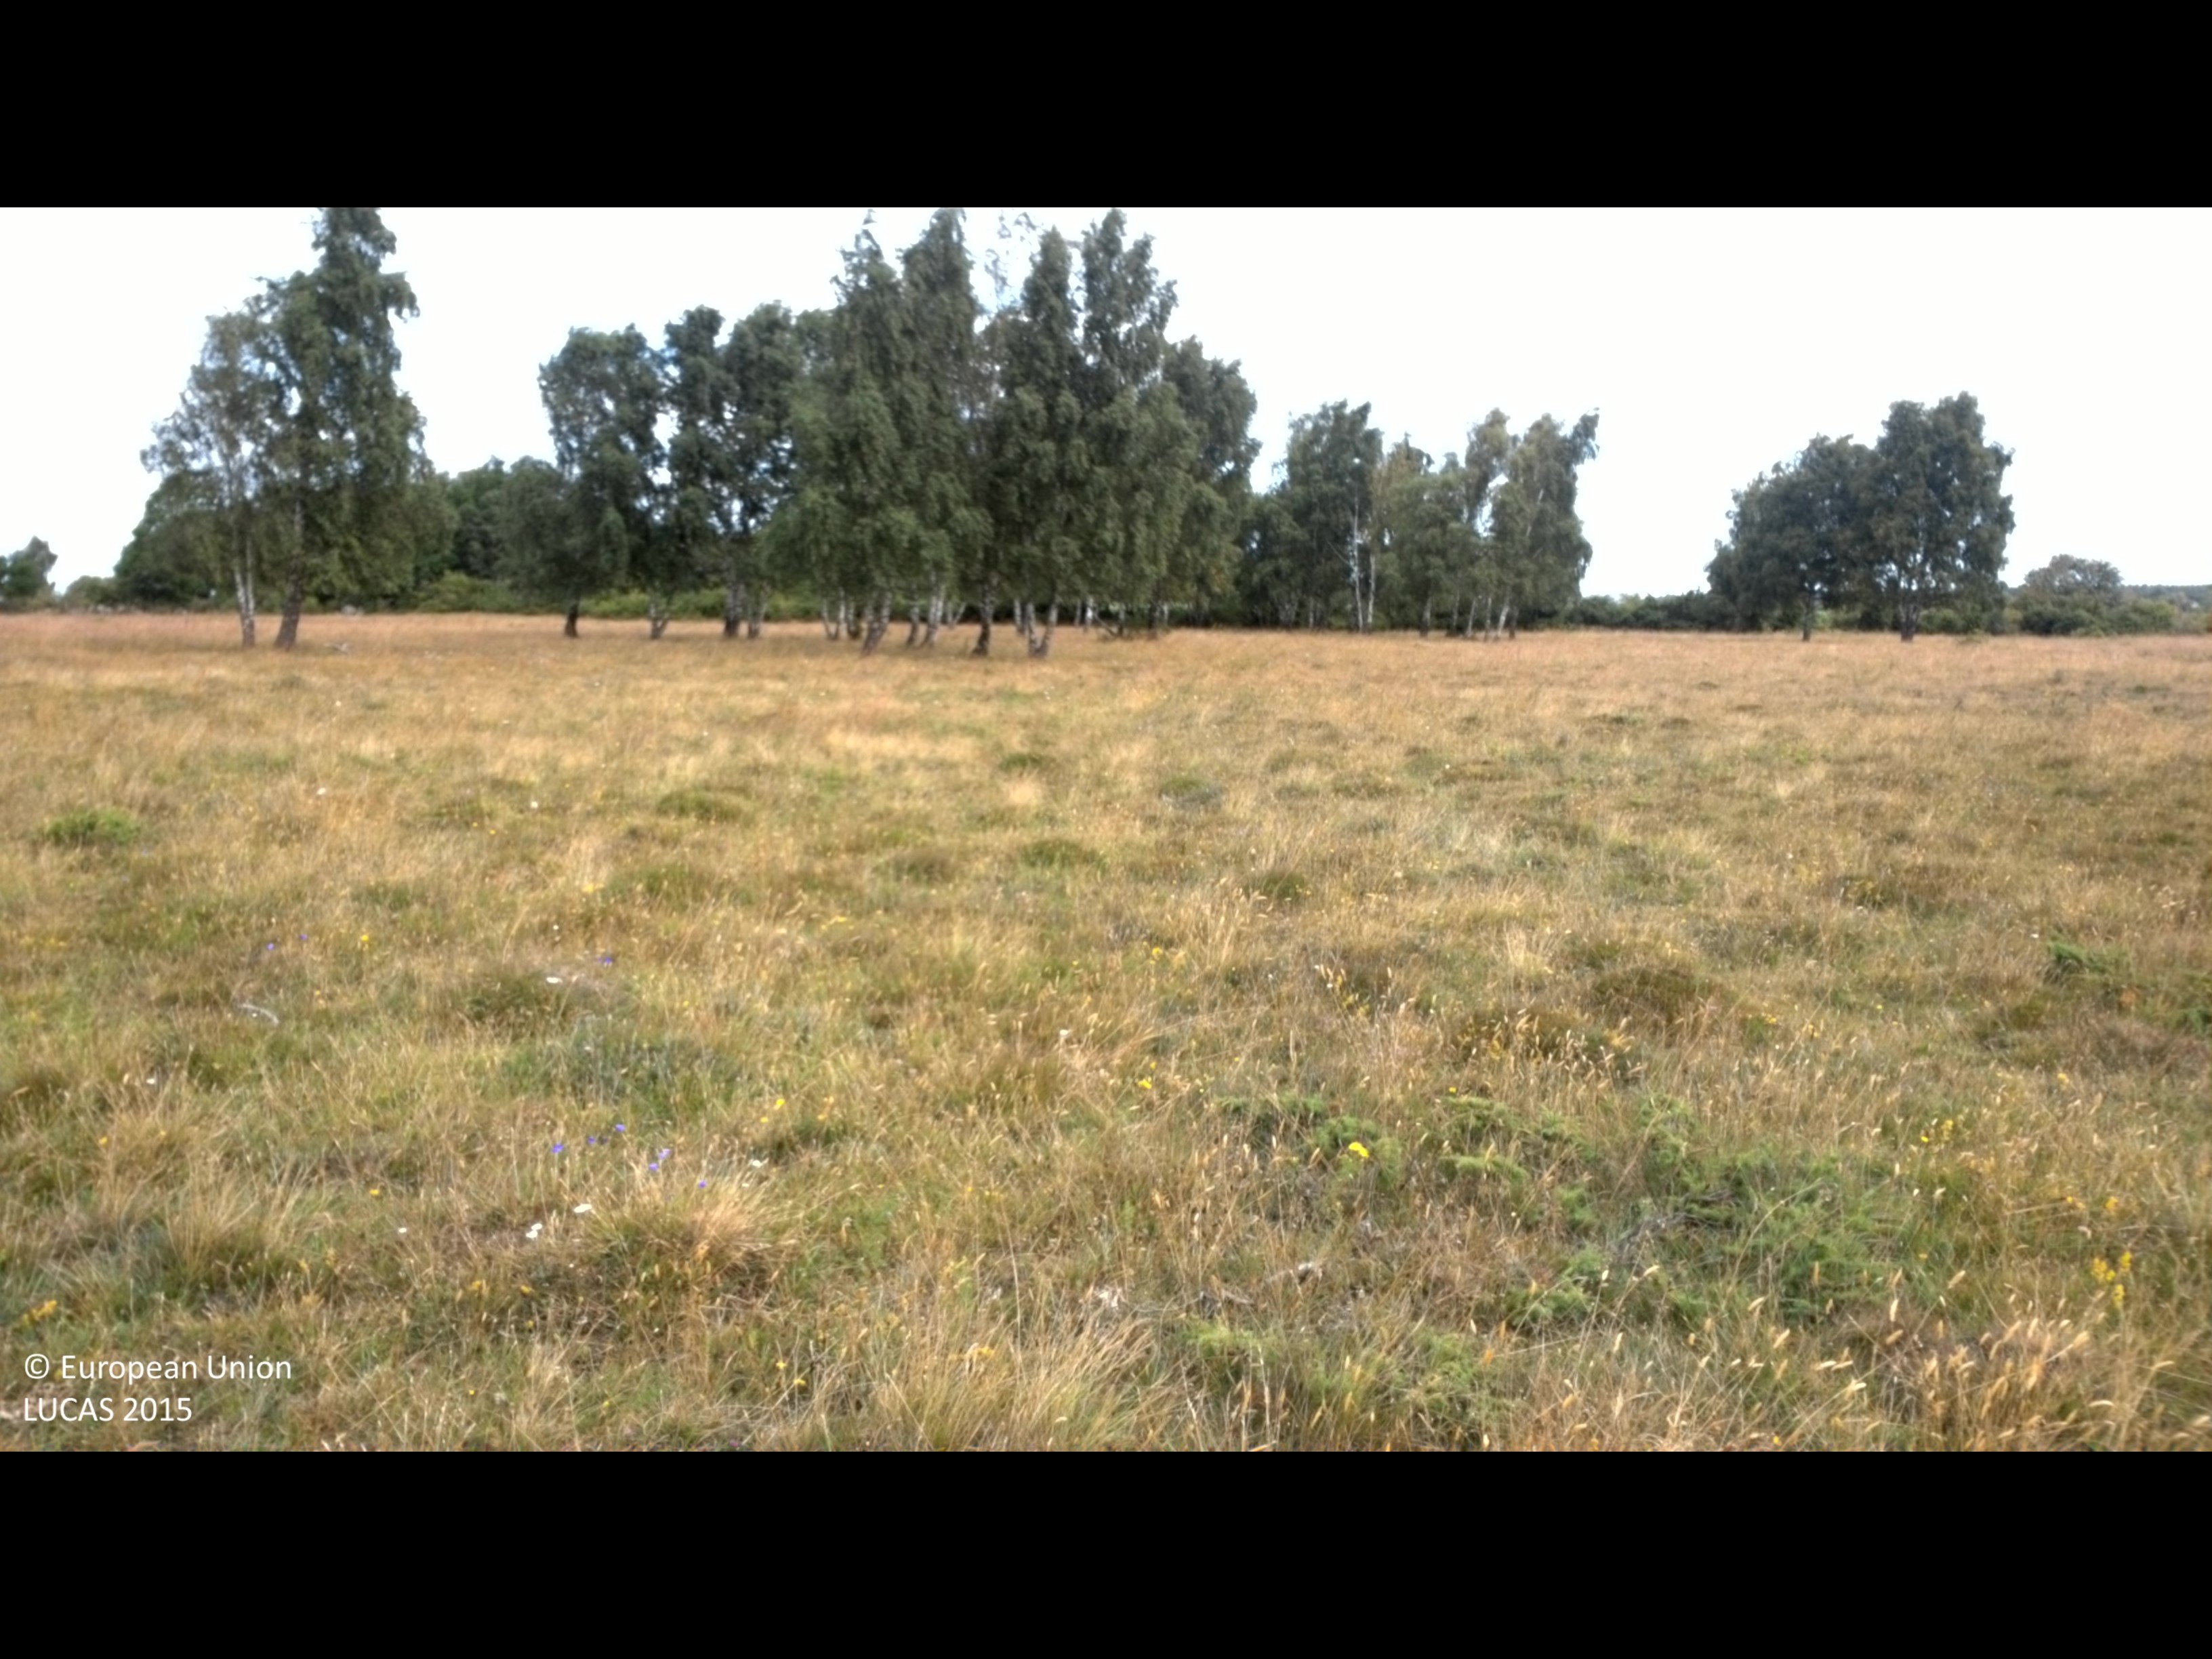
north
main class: Grassland
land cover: Grassland without tree/shrub cover
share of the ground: > 75 %
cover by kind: herbaceous plants 95 %, shrubs 5 %
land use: Agriculture (excluding fallow land and kitchen gardens)
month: July
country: SE
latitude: 56.4800
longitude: 16.3825
